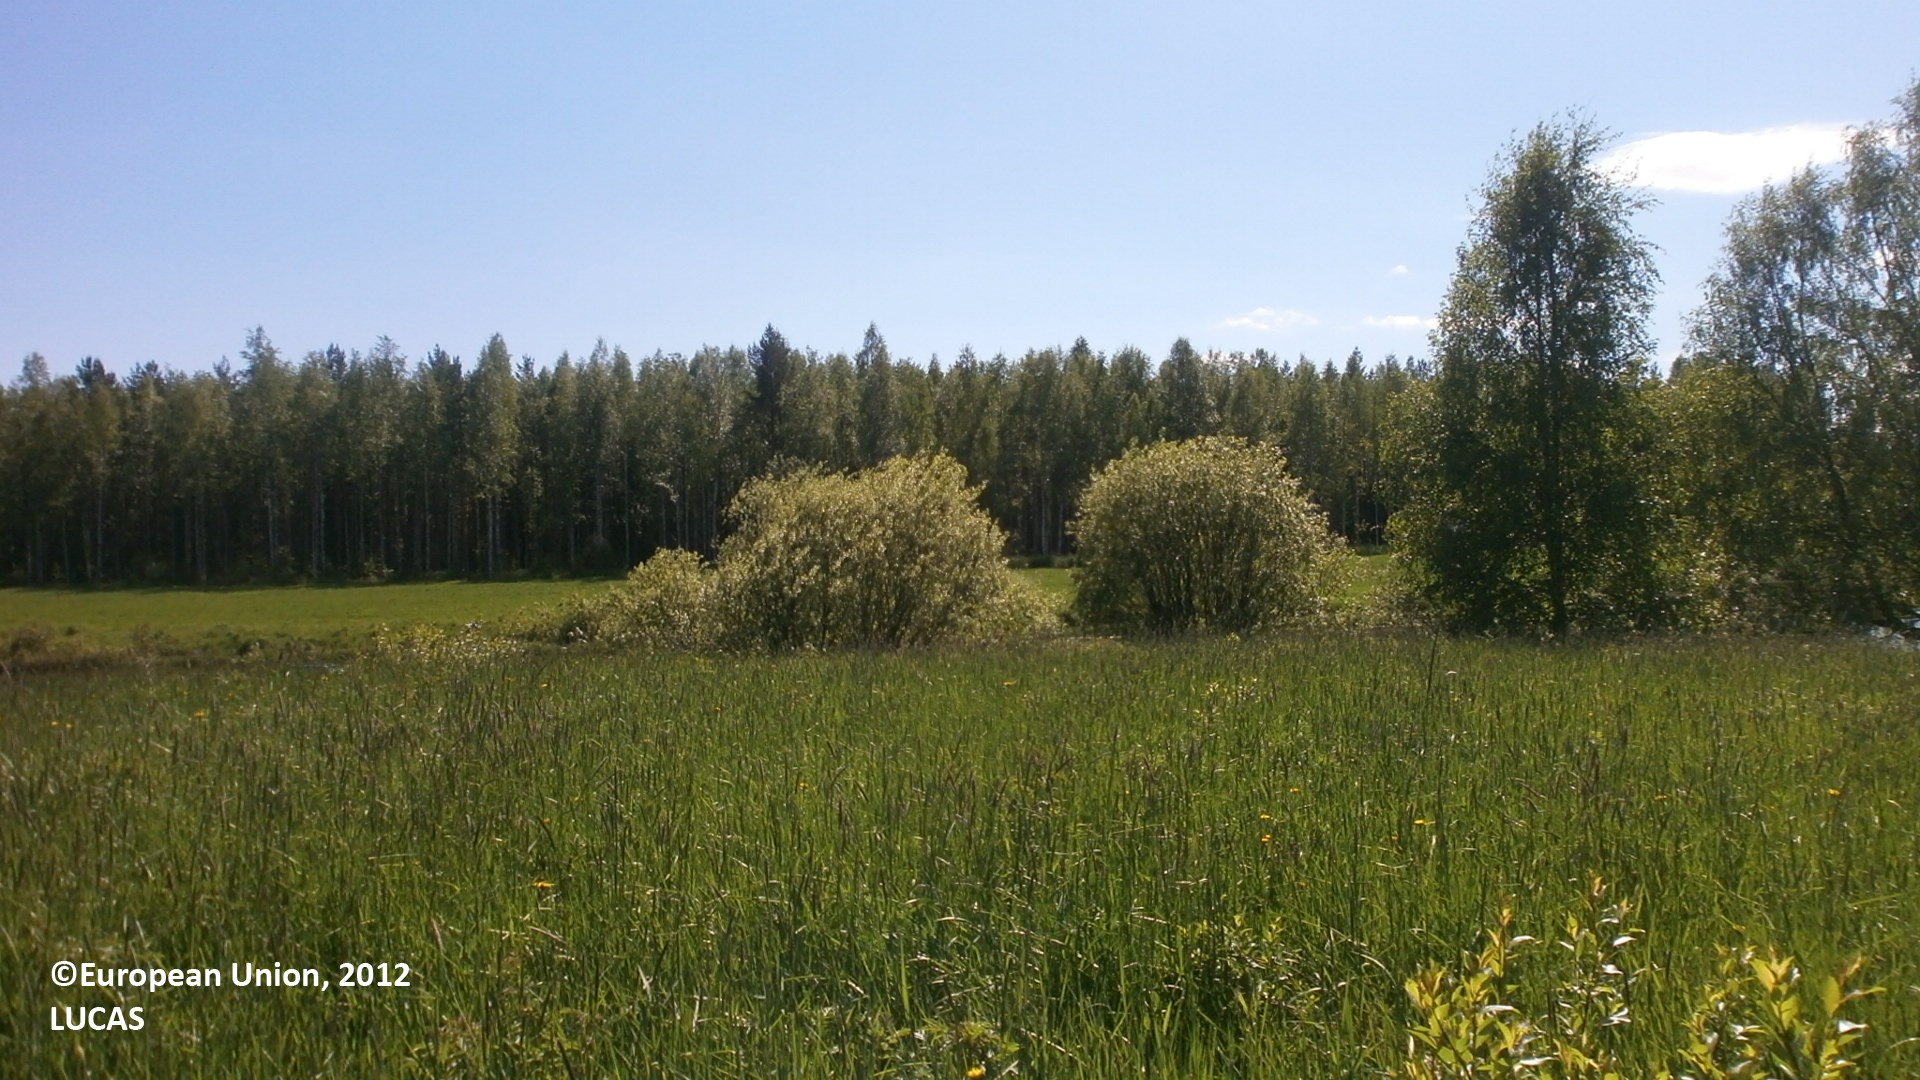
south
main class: Grassland
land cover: Grassland without tree/shrub cover
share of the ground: > 75 %
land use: Agriculture (excluding fallow land and kitchen gardens)
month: June
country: FI
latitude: 63.9803
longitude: 25.6897
